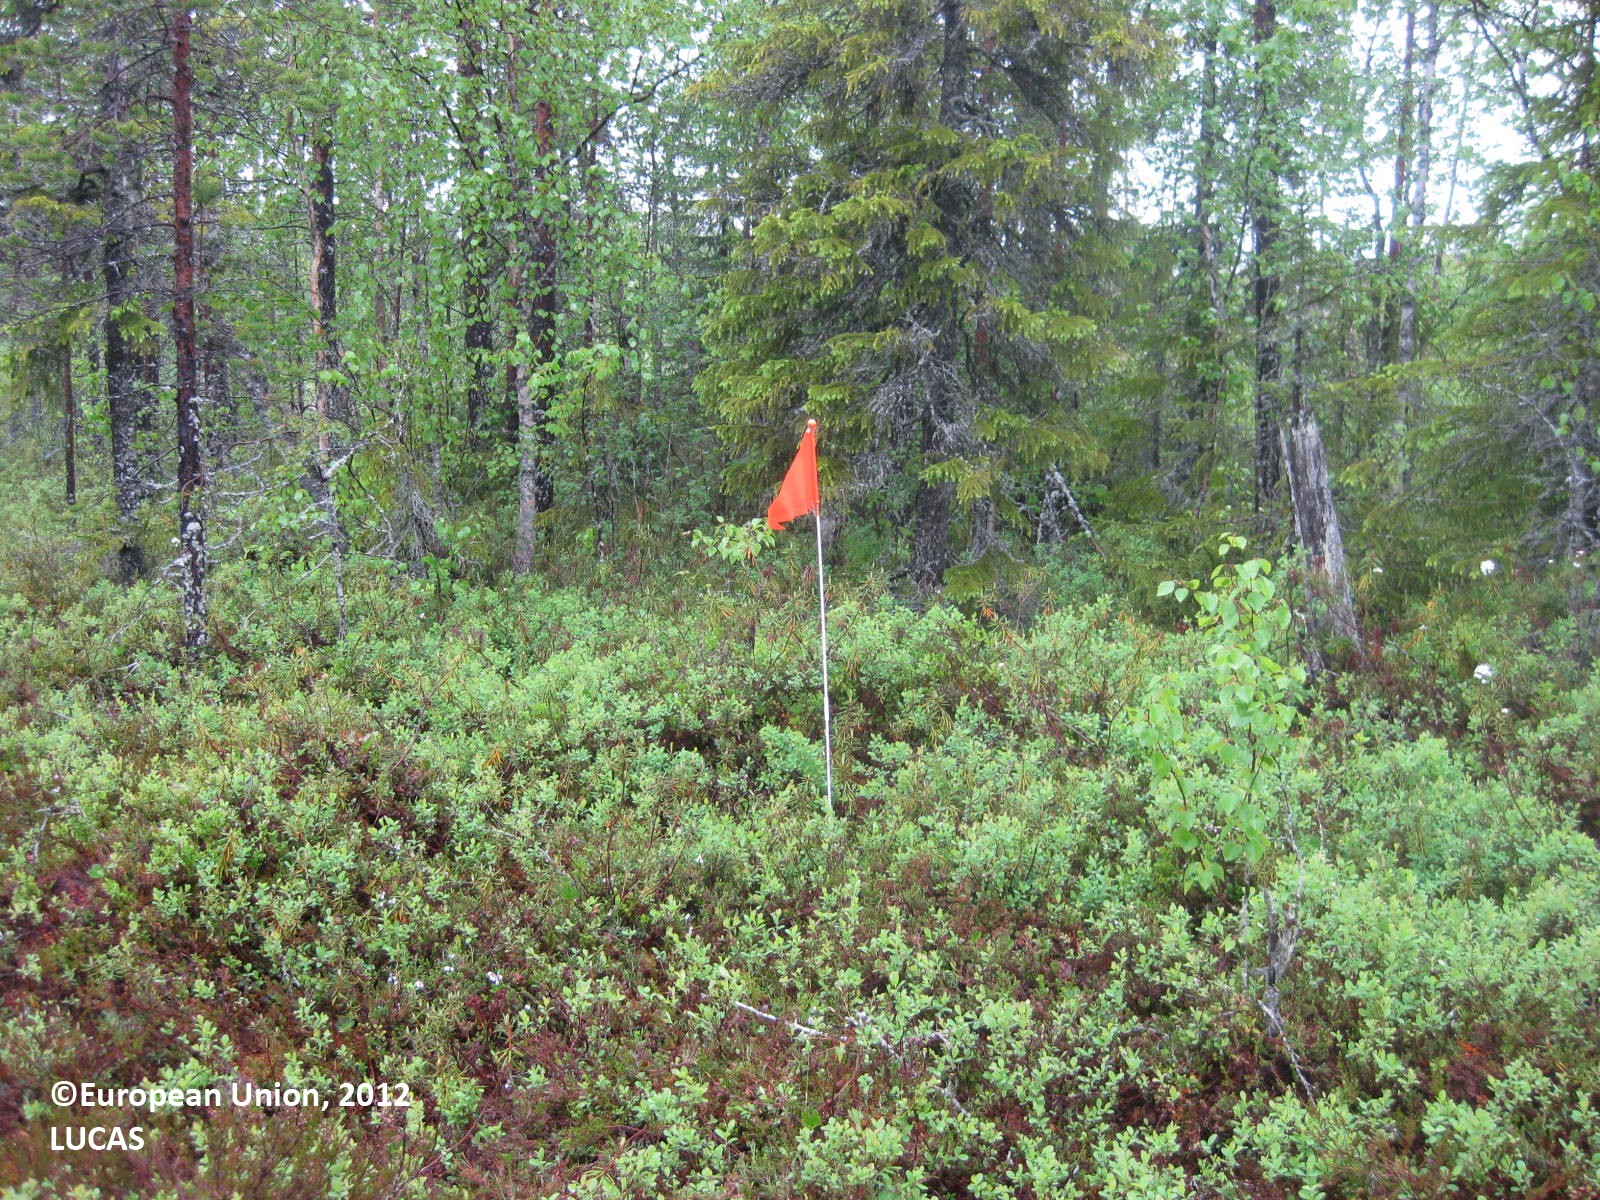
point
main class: Woodland
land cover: Pine dominated mixed woodland
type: boreal forest
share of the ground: 50 - 75 %
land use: Forestry
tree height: > 5 m
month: June
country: FI
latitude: 65.2758
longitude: 28.9740
